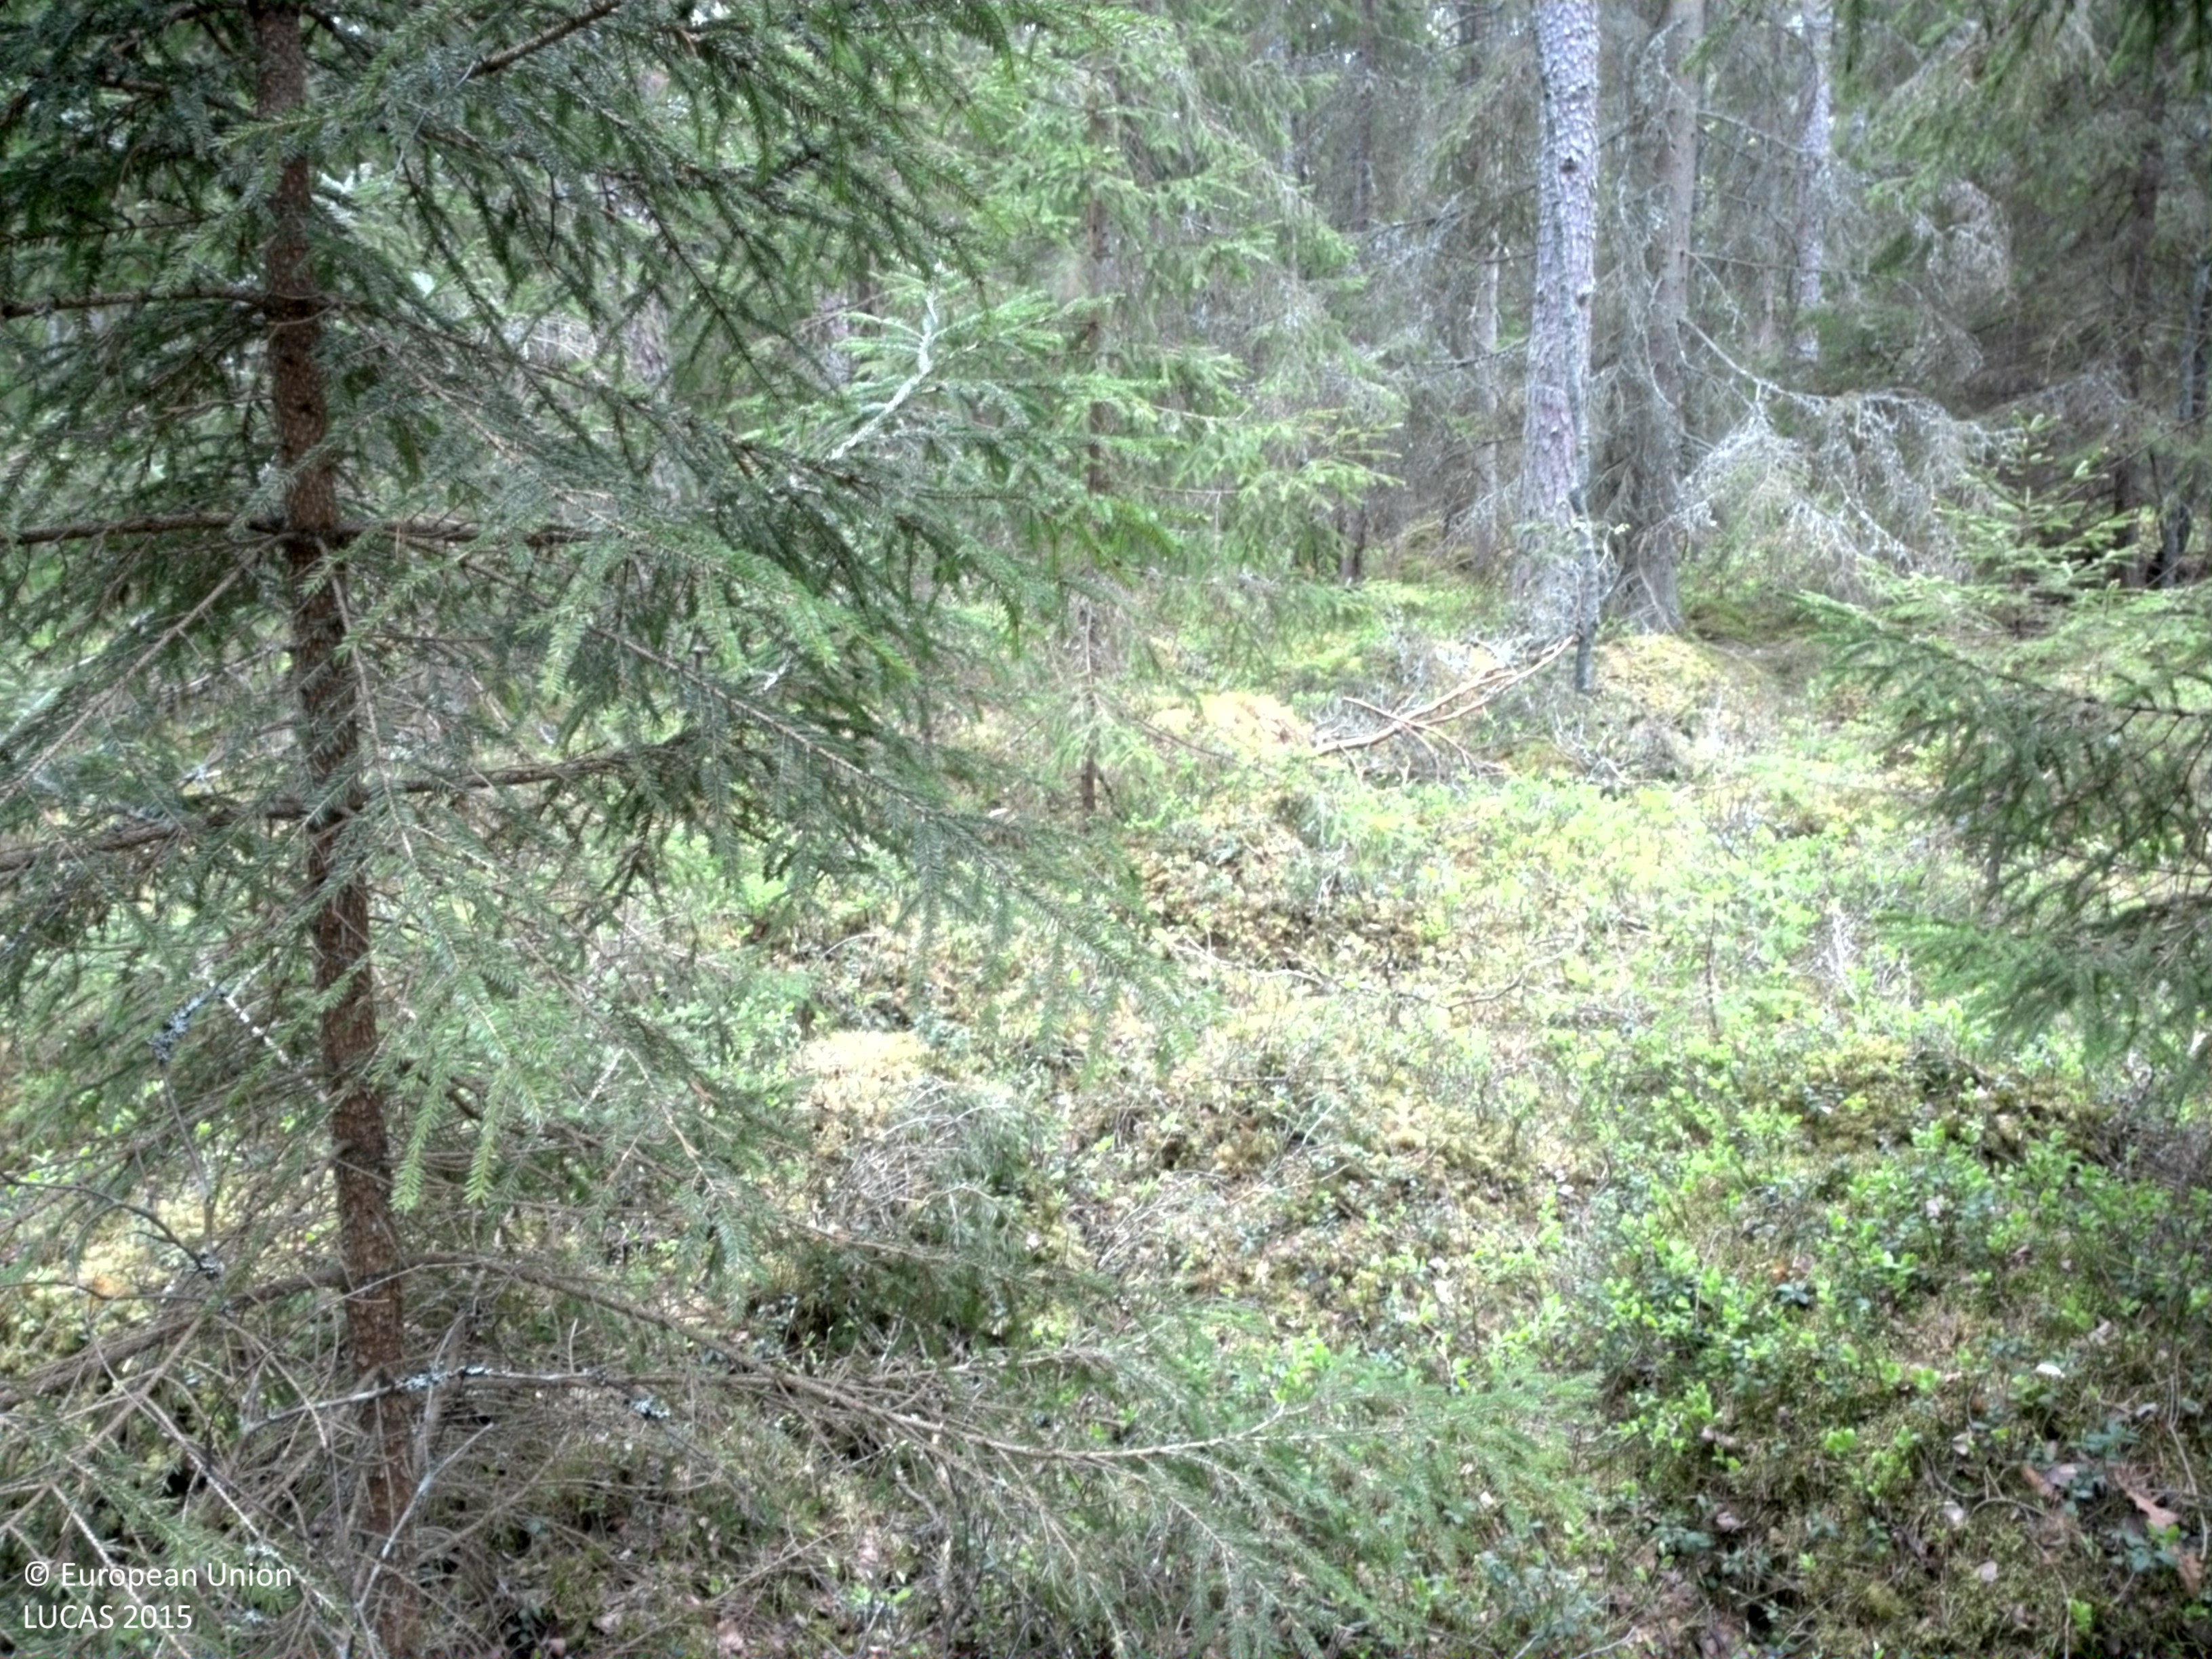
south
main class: Woodland
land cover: Spruce dominated mixed woodland
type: boreal forest
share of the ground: 50 - 75 %
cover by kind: coniferous forest trees 50 %, broadleaved forest trees 25 %, shrubs 15 %, lichens and mosses 10 %
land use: Forestry
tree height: > 5 m
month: May
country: SE
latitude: 56.7034
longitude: 15.4373
